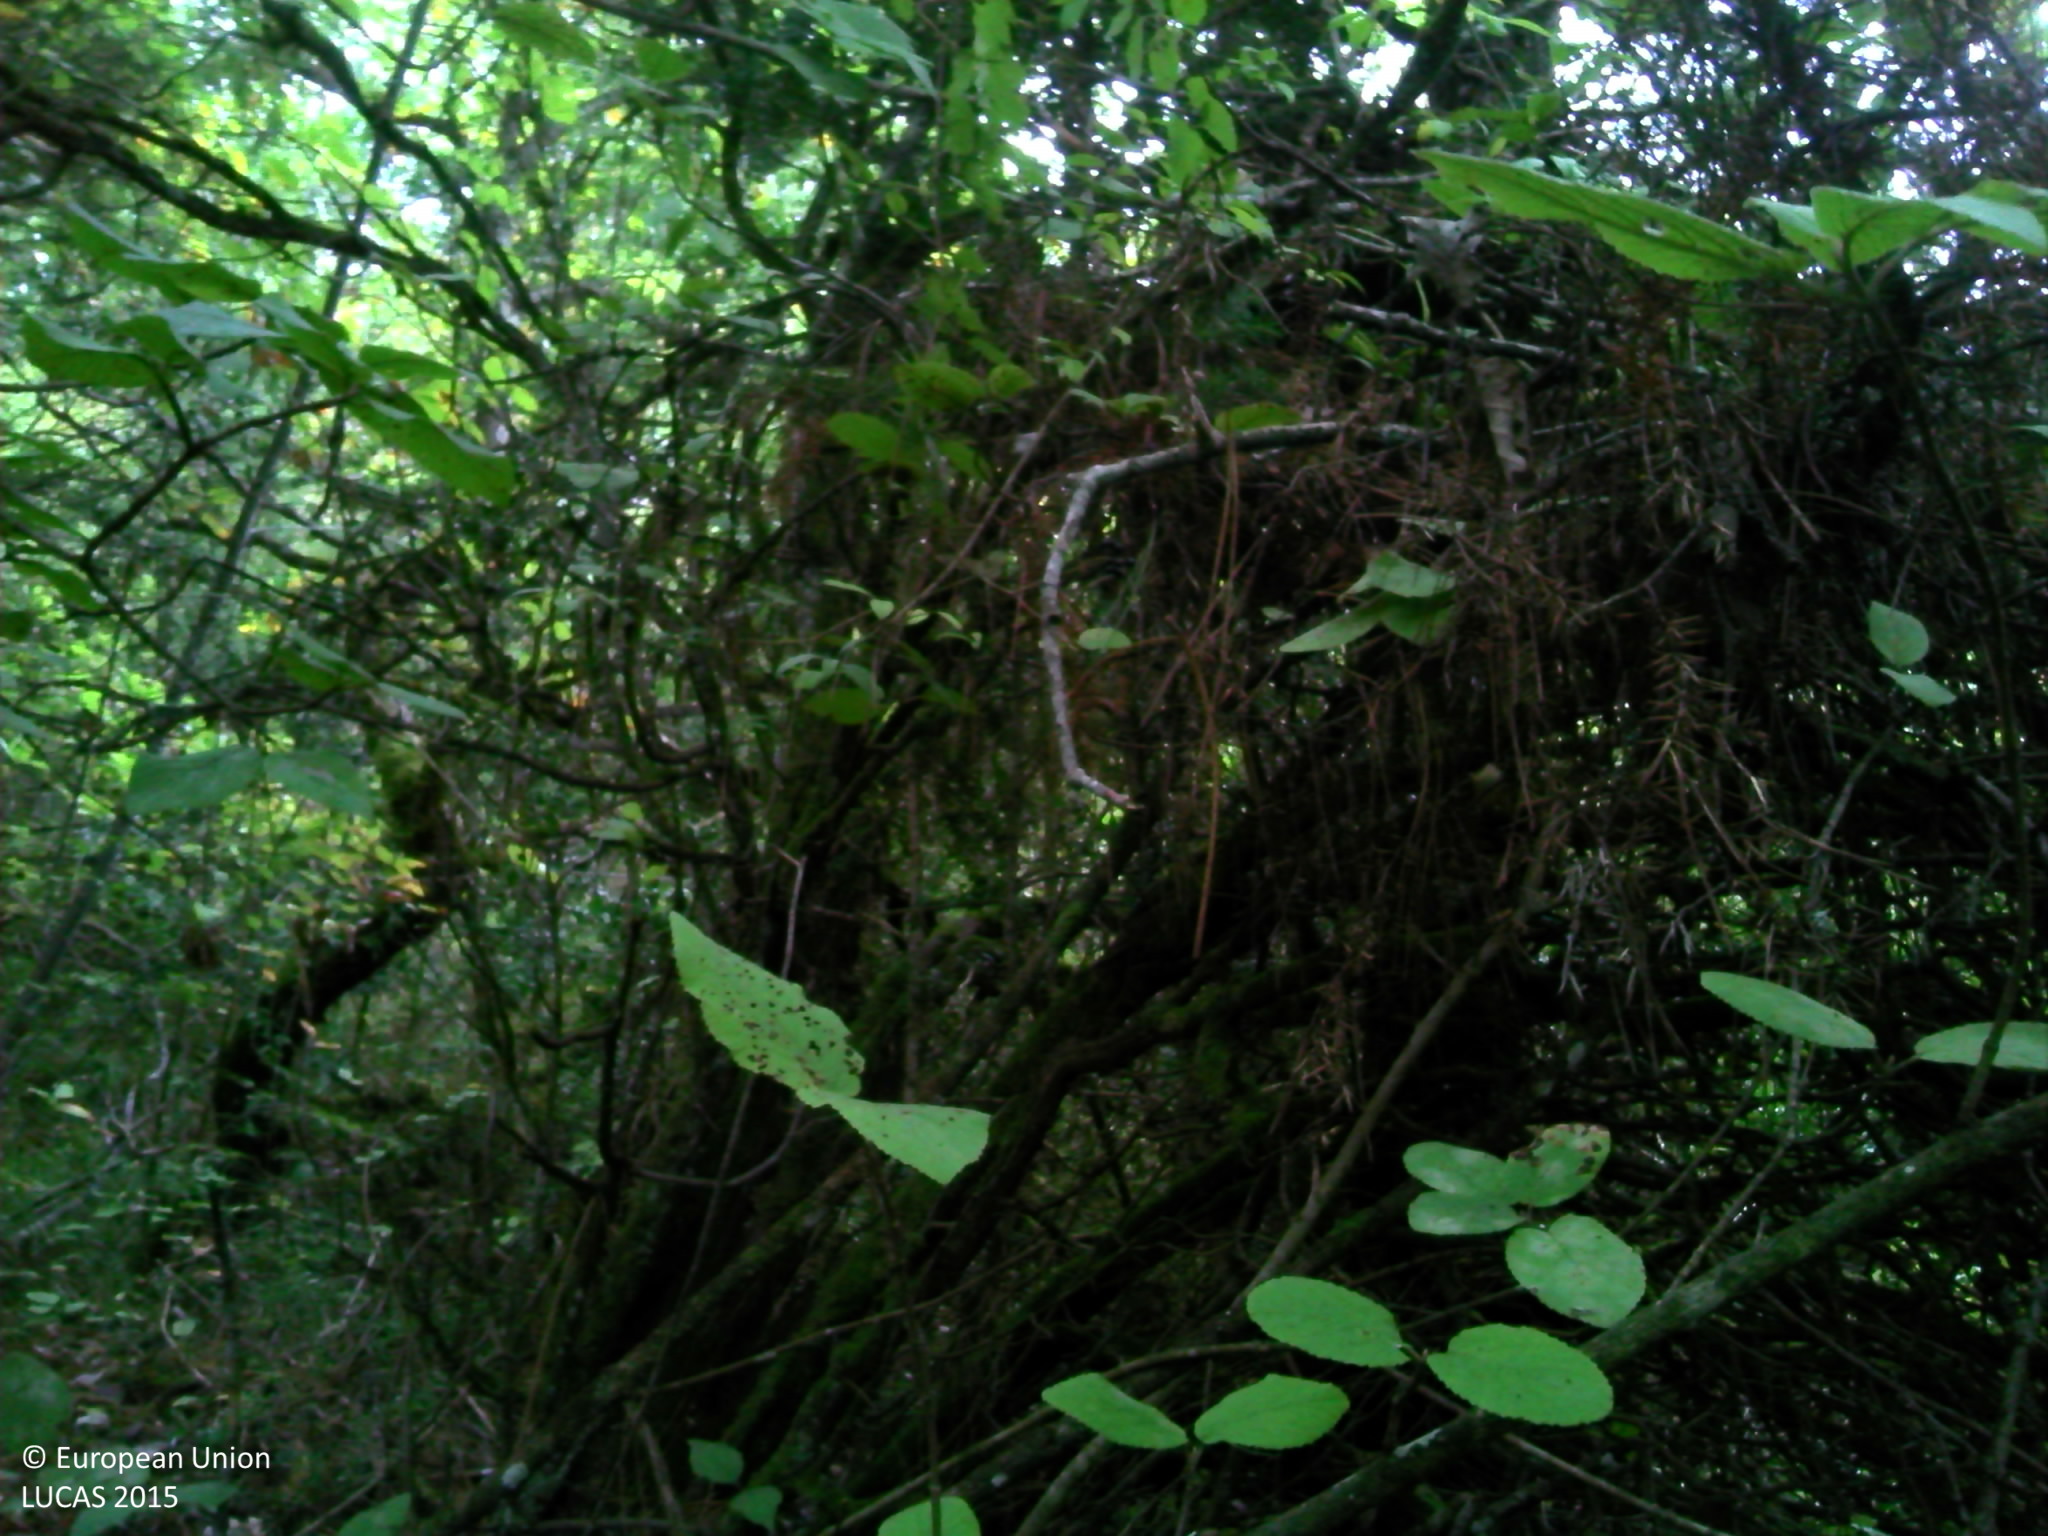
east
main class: Woodland
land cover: Pine dominated mixed woodland
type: hemiboreal forest and nemoral coniferous forest and mixed broadleaved-coniferous forest
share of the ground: > 75 %
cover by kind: coniferous forest trees 70 %, broadleaved forest trees 25 %, shrubs 5 %
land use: Forestry
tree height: > 5 m
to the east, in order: Pine dominated mixed woodland; Broadleaved woodland; Other mixed woodland; Rock outcrops; Broadleaved woodland; Tracks; Broadleaved woodland
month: September
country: FR
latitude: 47.0151
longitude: 4.7255
